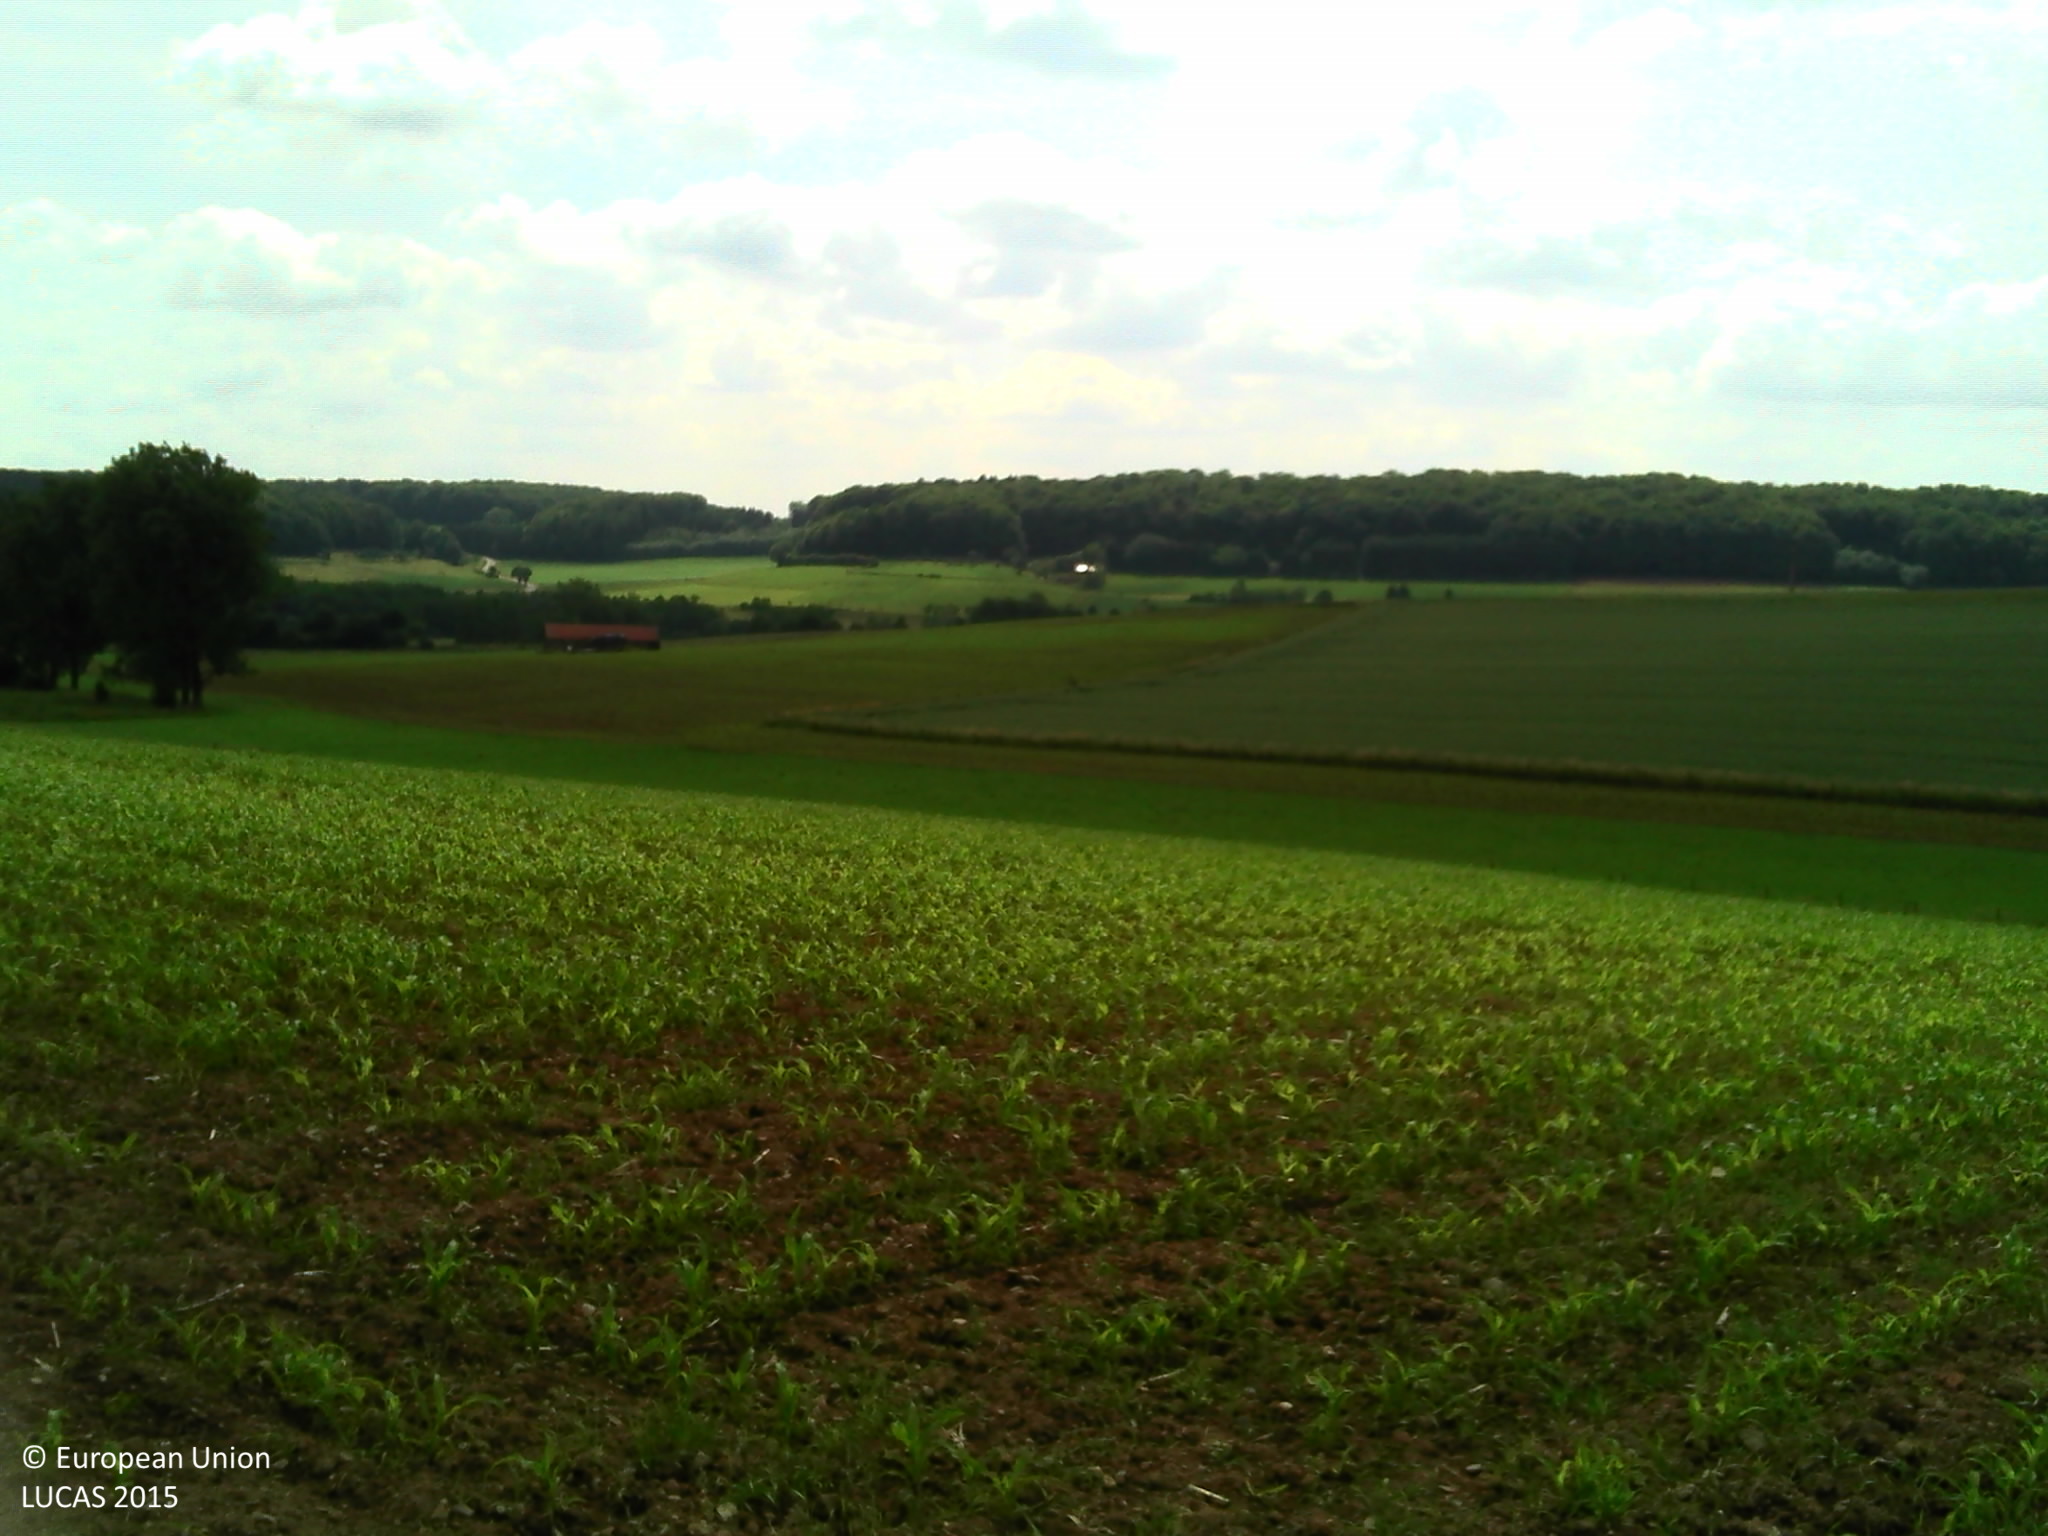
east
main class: Grassland
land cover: Grassland without tree/shrub cover
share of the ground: > 75 %
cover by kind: herbaceous plants 100 %
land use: Agriculture (excluding fallow land and kitchen gardens)
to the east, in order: Grassland without tree/shrub cover; Fences; Grassland without tree/shrub cover; Broadleaved woodland; Grassland without tree/shrub cover
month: June
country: LU
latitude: 49.8443
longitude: 6.0081
